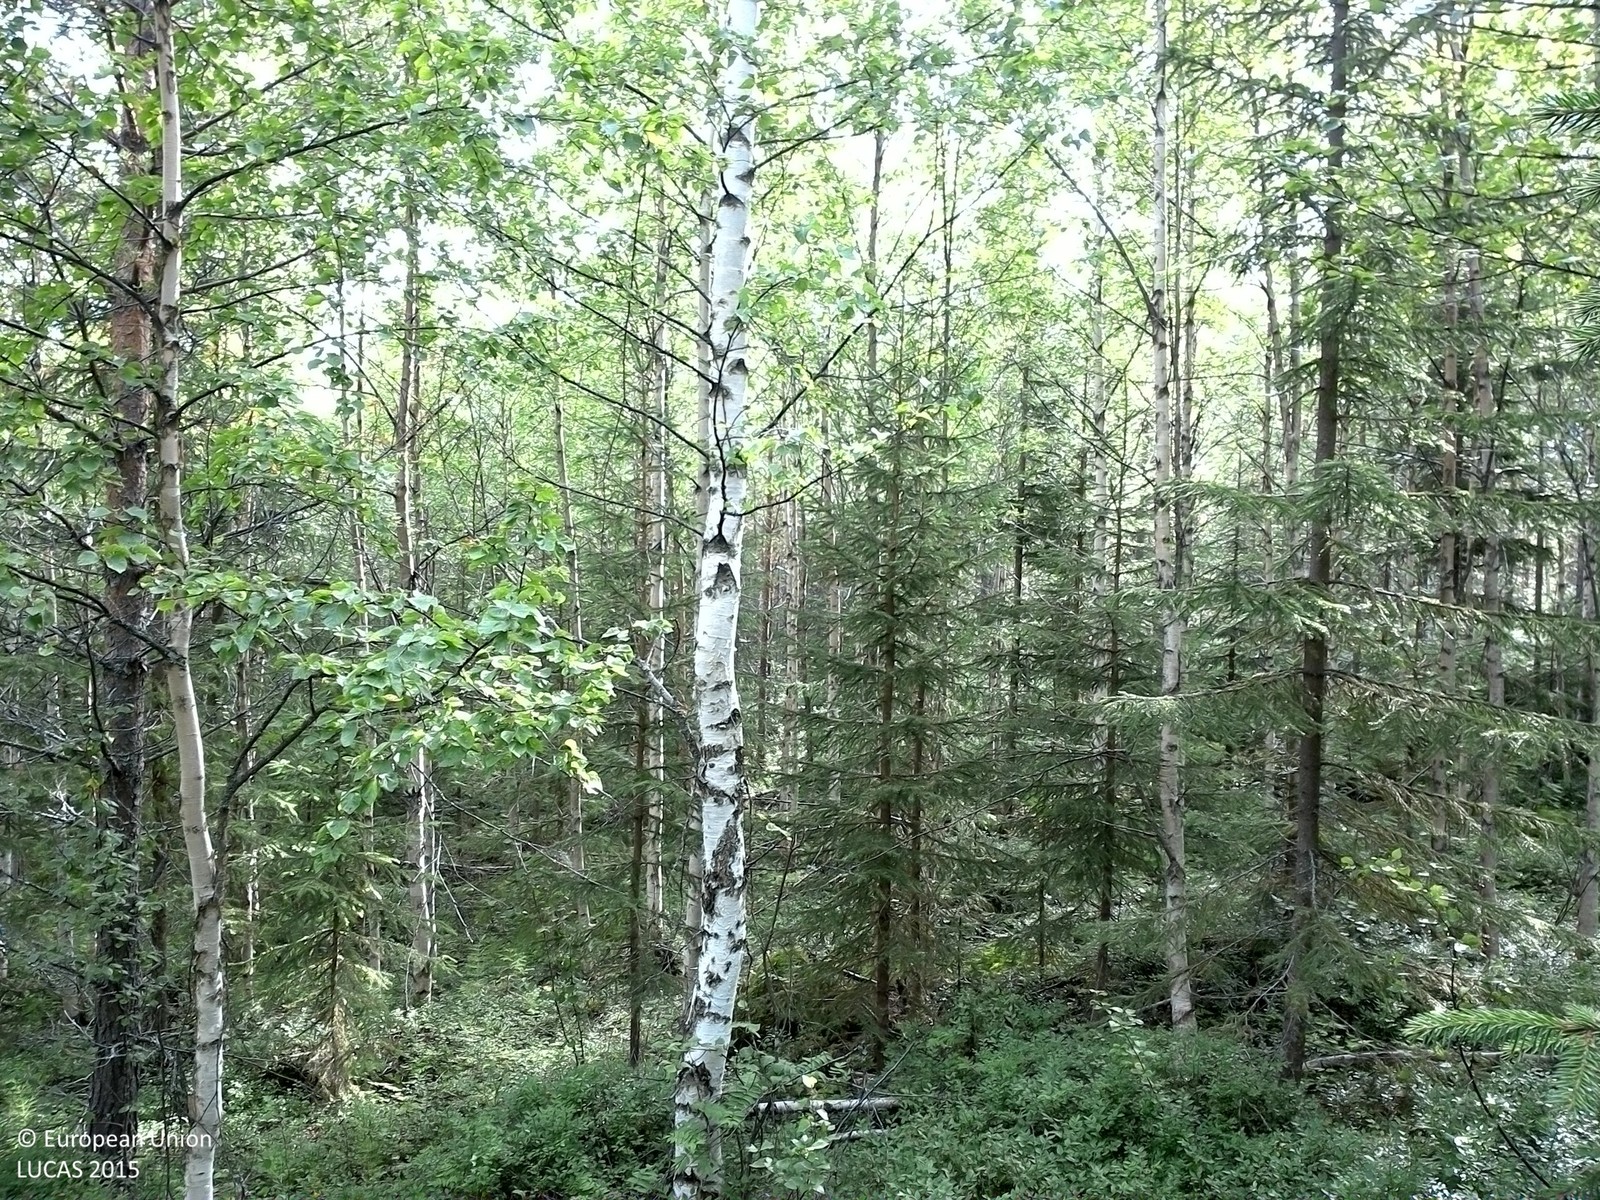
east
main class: Woodland
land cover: Spruce dominated mixed woodland
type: boreal forest
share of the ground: > 75 %
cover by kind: coniferous forest trees 40 %, broadleaved forest trees 35 %, shrubs 25 %
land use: Forestry
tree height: < 5 m
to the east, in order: Spruce dominated mixed woodland; Pine dominated mixed woodland; Groves; Paved roads, cycling and walking lanes; Spruce dominated mixed woodland; Pine dominated mixed woodland; Spruce dominated mixed woodland; Pine dominated mixed woodland
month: August
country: SE
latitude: 63.7131
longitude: 18.2108
